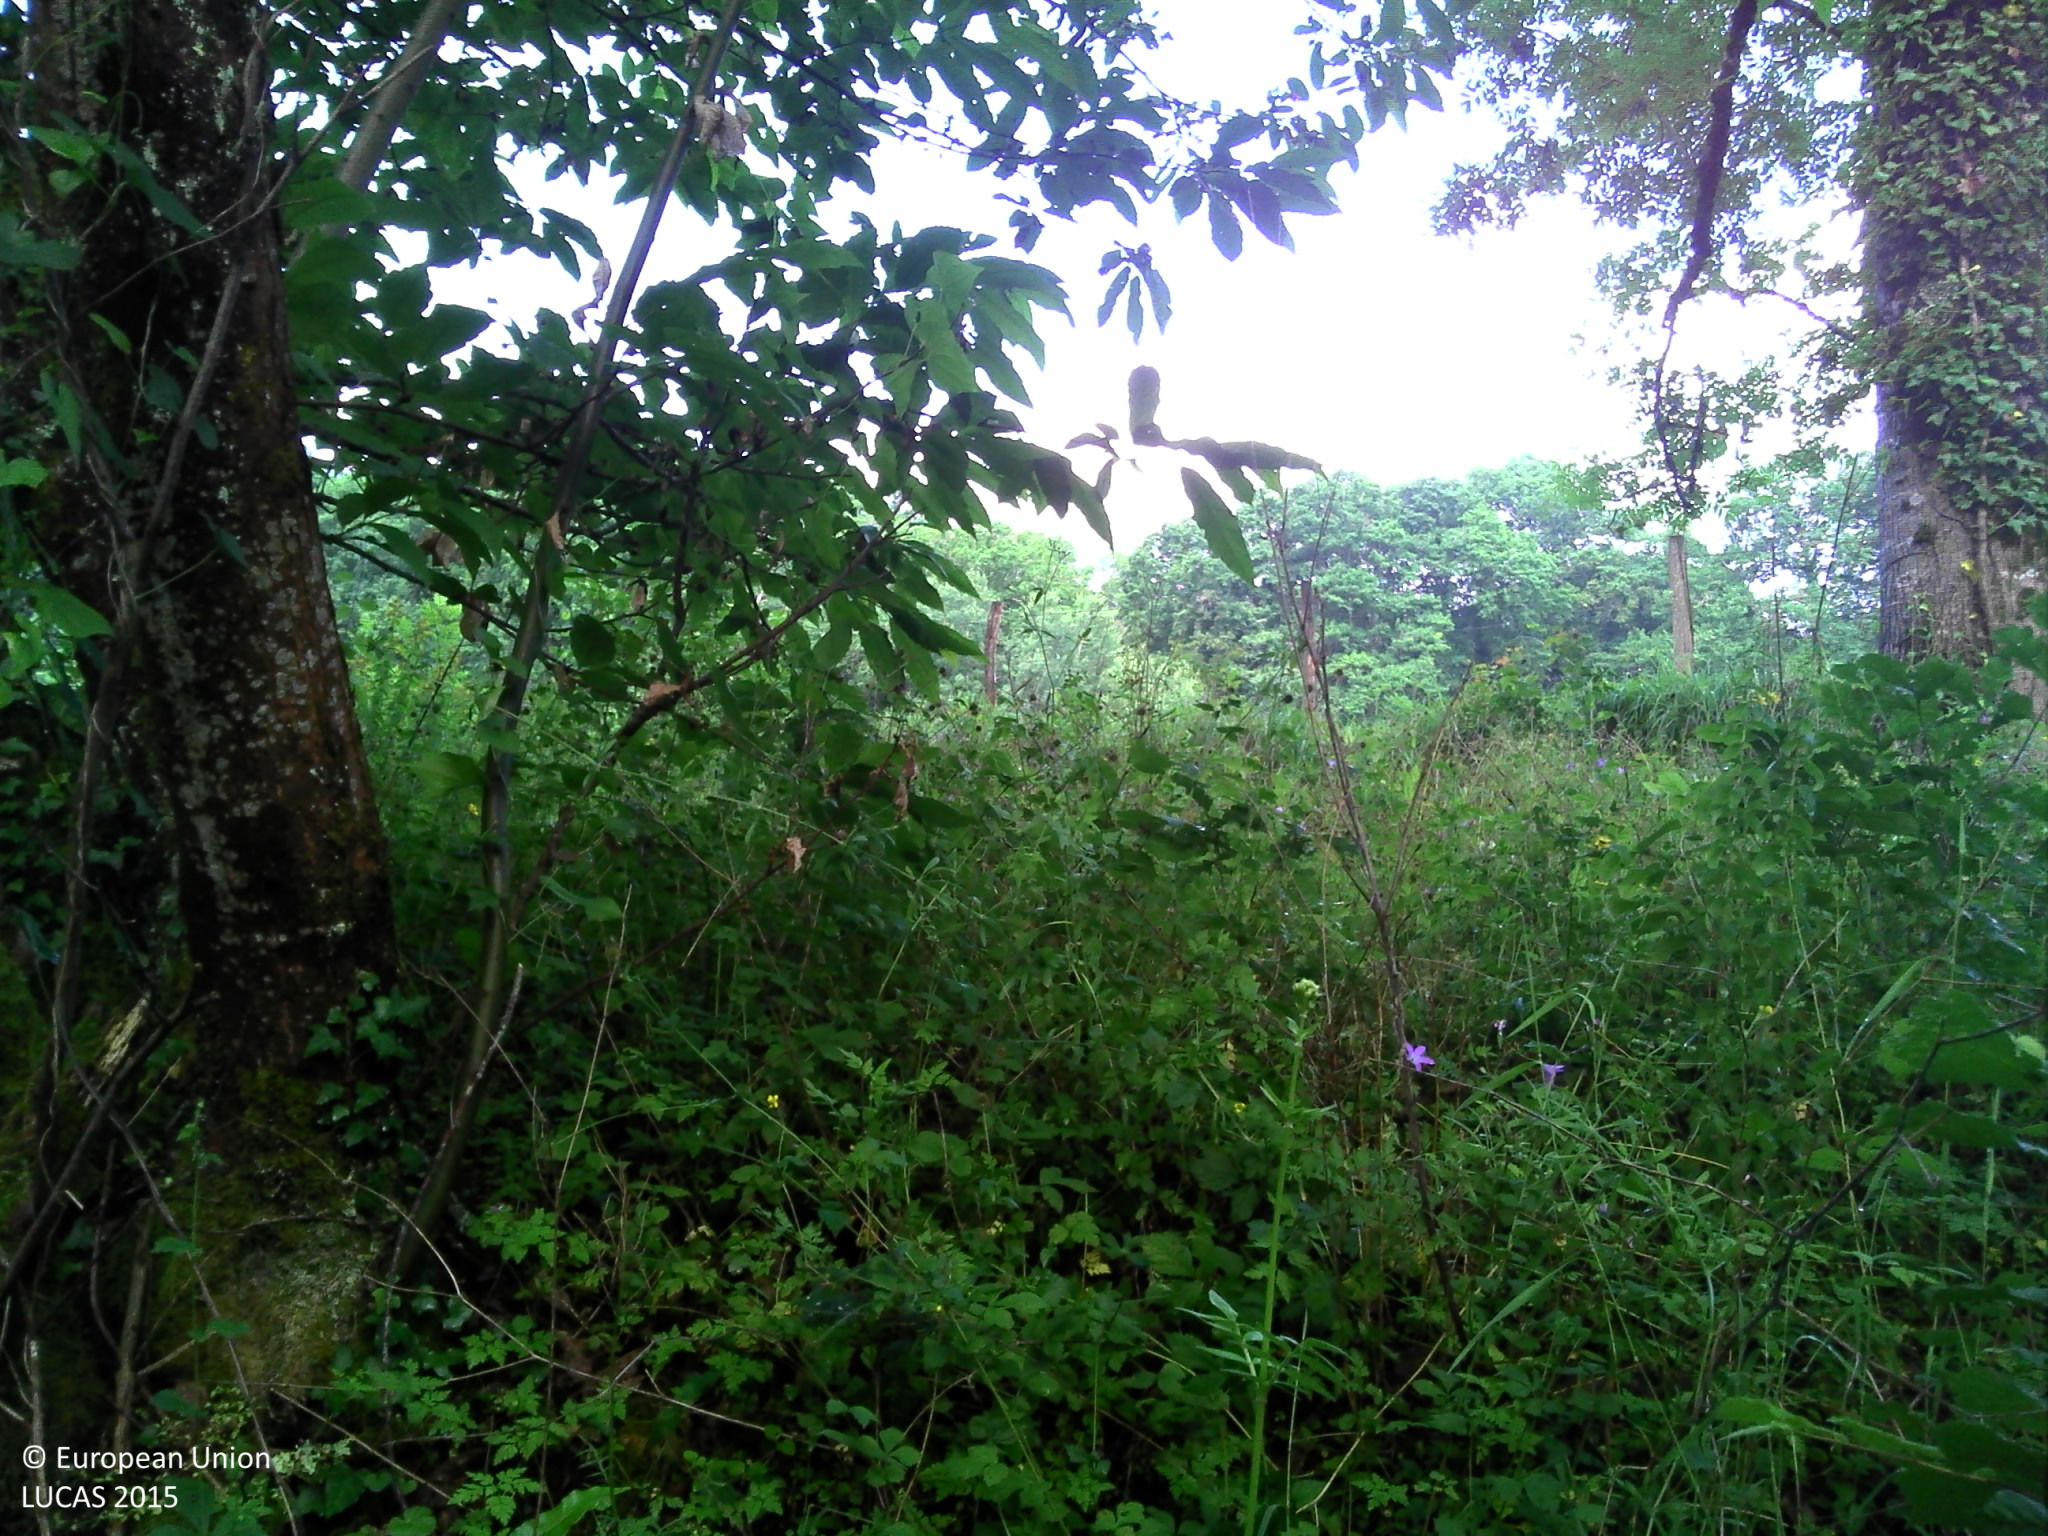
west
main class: Woodland
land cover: Broadleaved woodland
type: acidophilous oak and oak-birch forest
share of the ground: > 75 %
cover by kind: broadleaved forest trees 70 %, shrubs 10 %, herbaceous plants 10 %, lichens and mosses 10 %
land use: Forestry
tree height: > 5 m
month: June
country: FR
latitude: 43.2183
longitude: -0.6570
